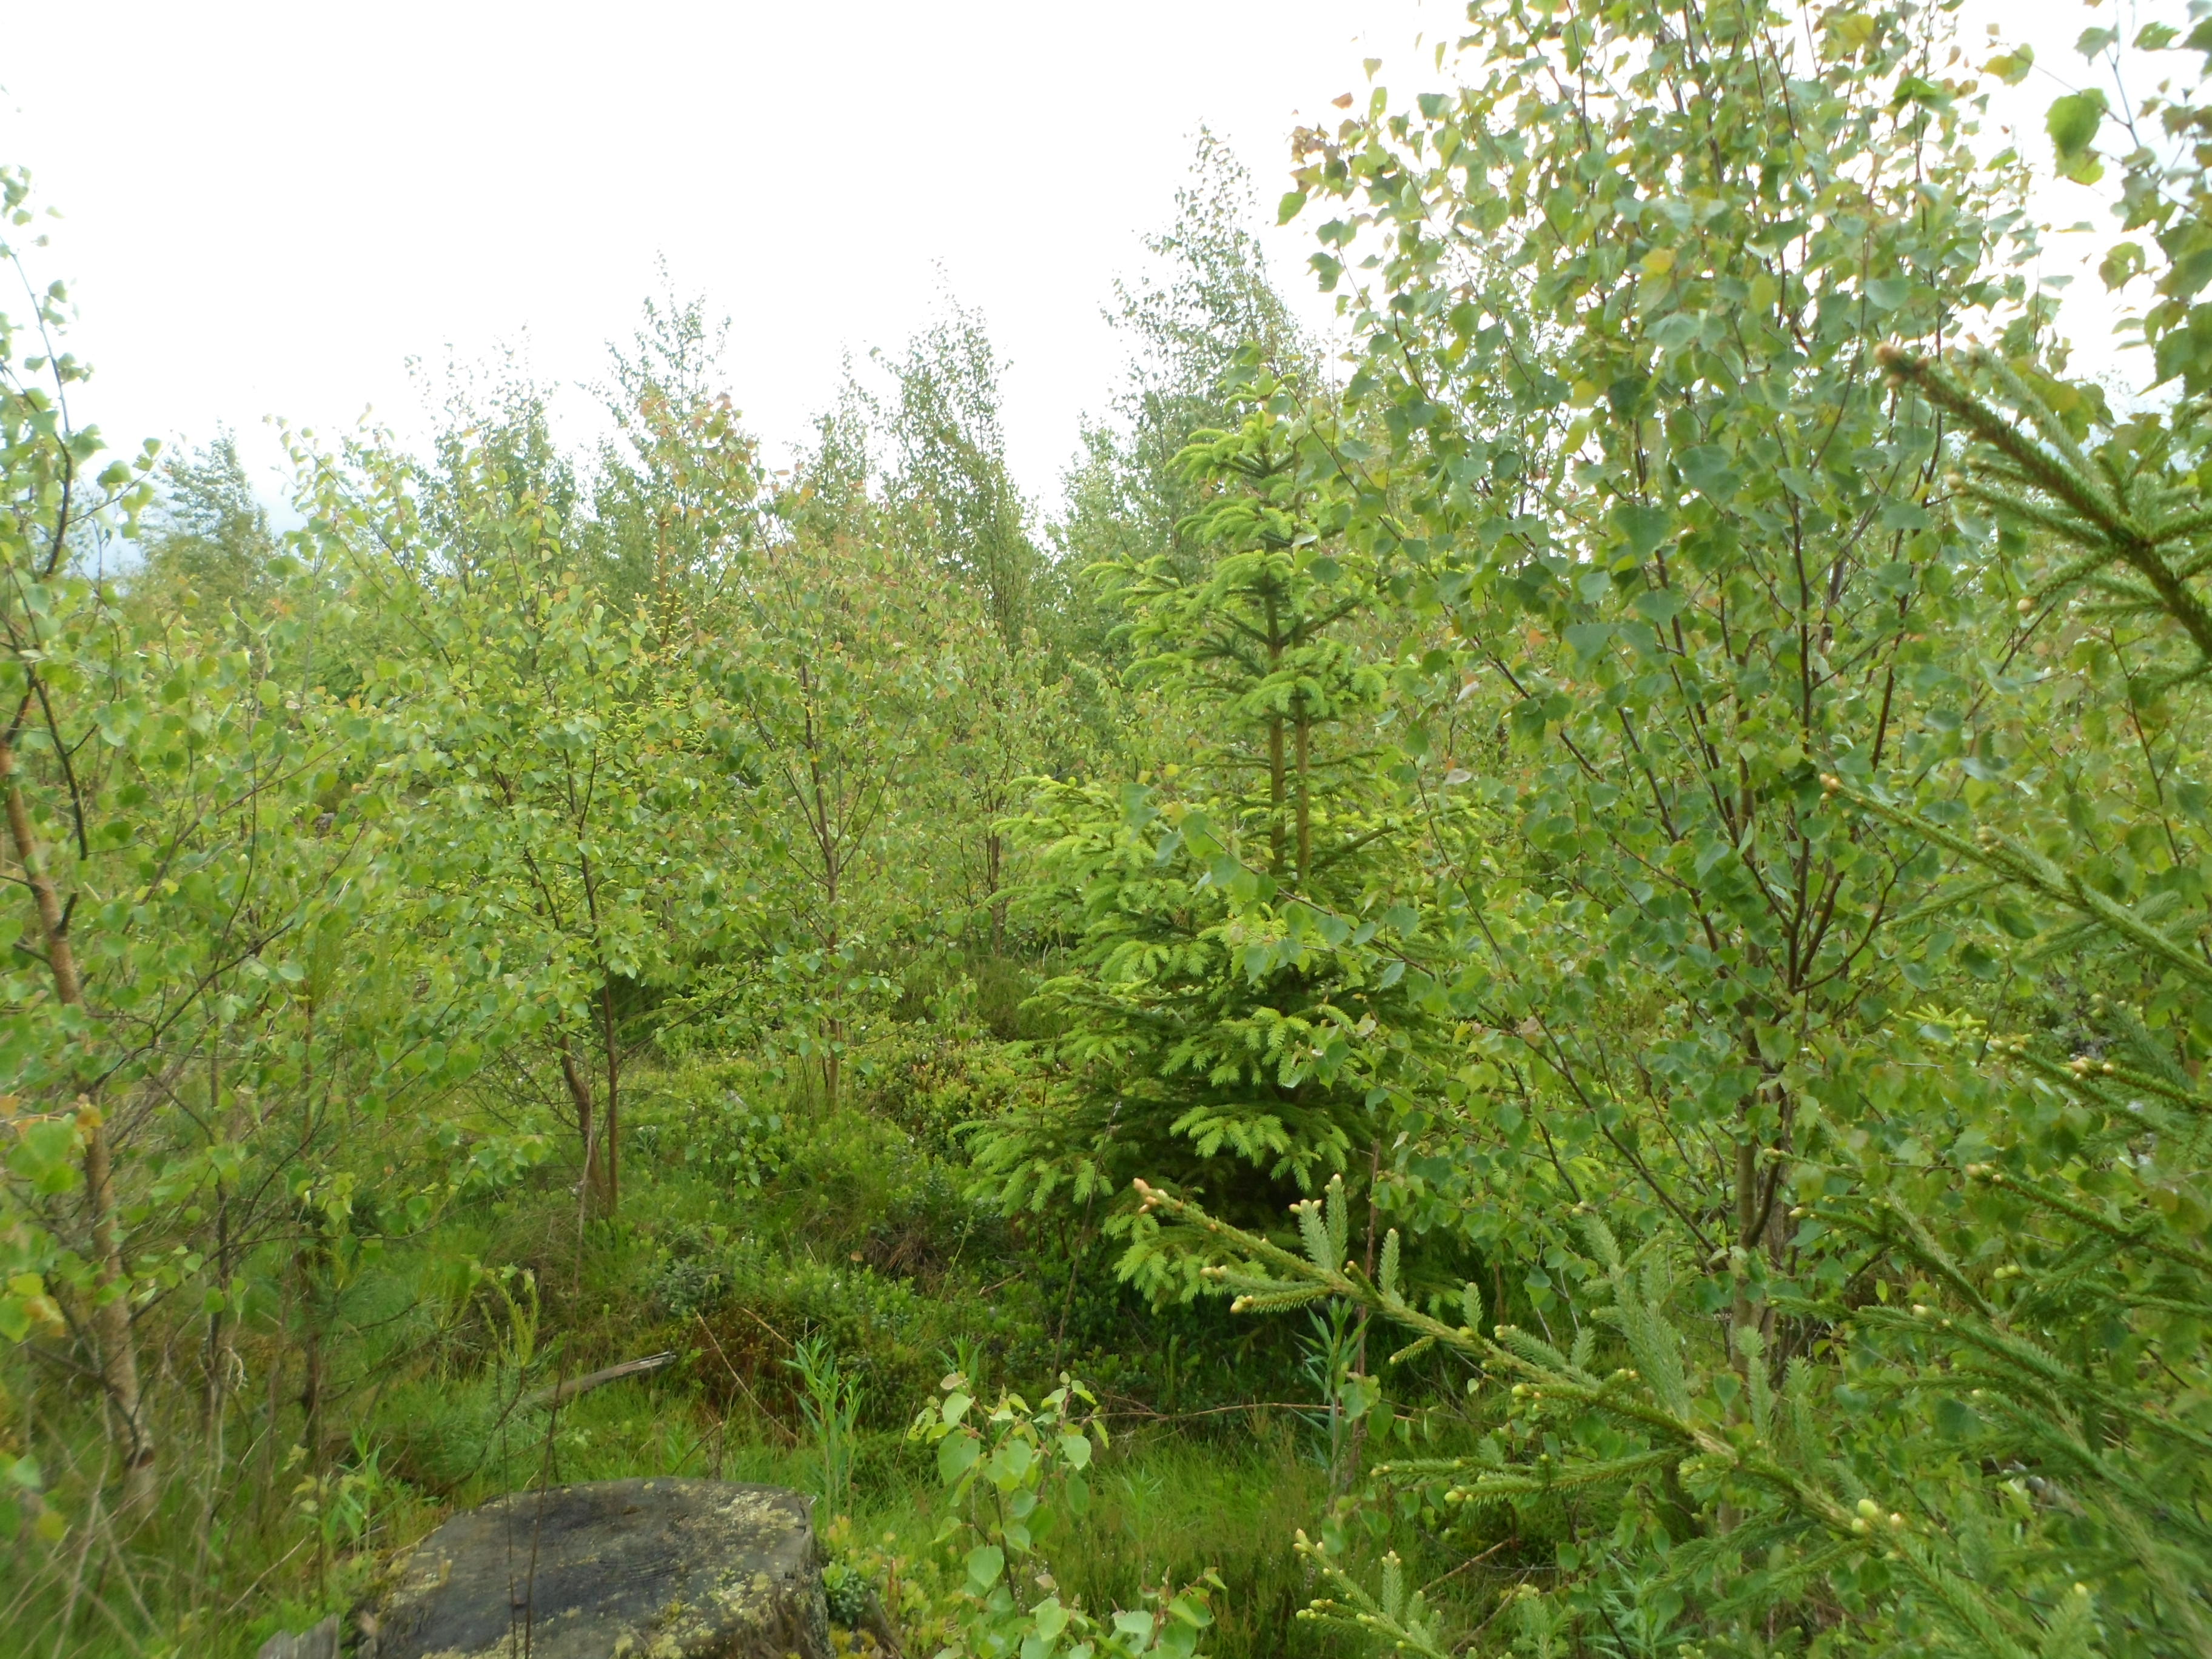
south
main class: Woodland
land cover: Spruce dominated mixed woodland
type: boreal forest
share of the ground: > 75 %
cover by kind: broadleaved forest trees 45 %, coniferous forest trees 35 %, shrubs 10 %, herbaceous plants 10 %
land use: Forestry
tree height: > 5 m
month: June
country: SE
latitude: 57.0096
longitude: 14.4921
